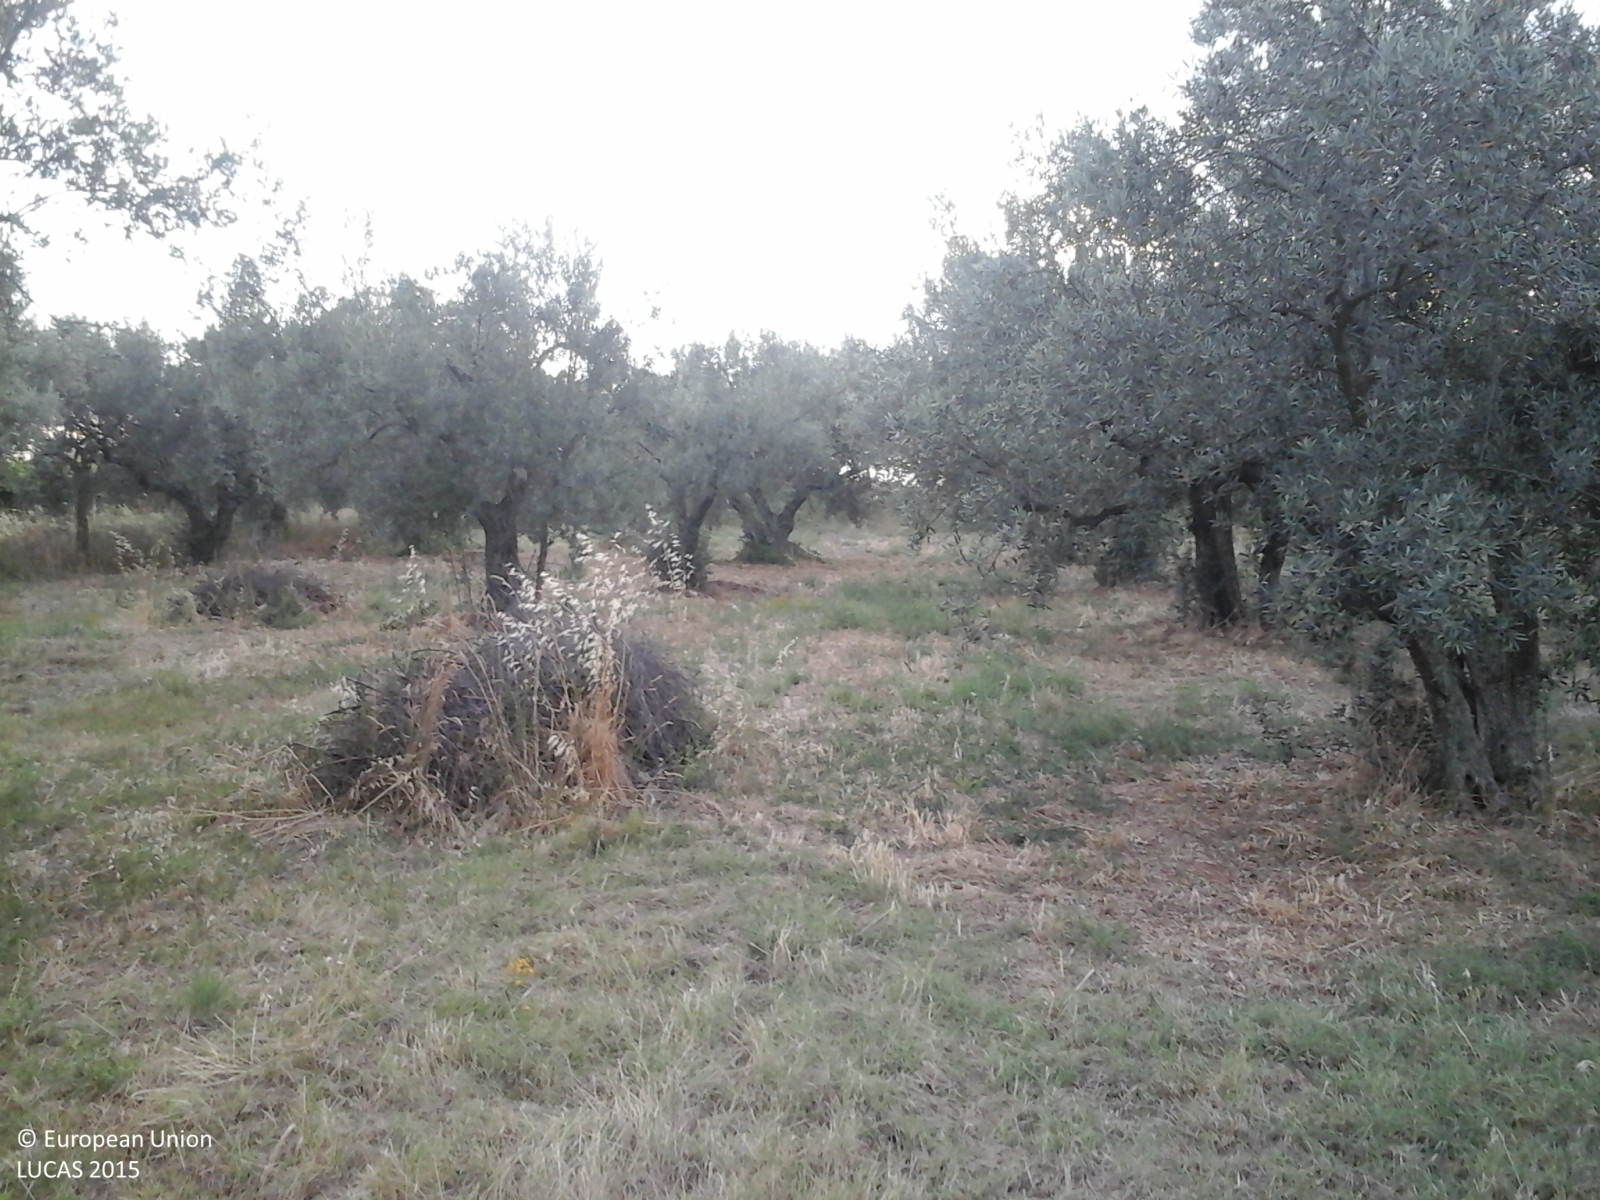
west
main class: Cropland
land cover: Olive groves
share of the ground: 25 - 50 %
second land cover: Spontaneously vegetated surfaces
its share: > 75 %
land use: Agriculture (excluding fallow land and kitchen gardens)
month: June
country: IT
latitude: 42.2366
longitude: 14.3128
